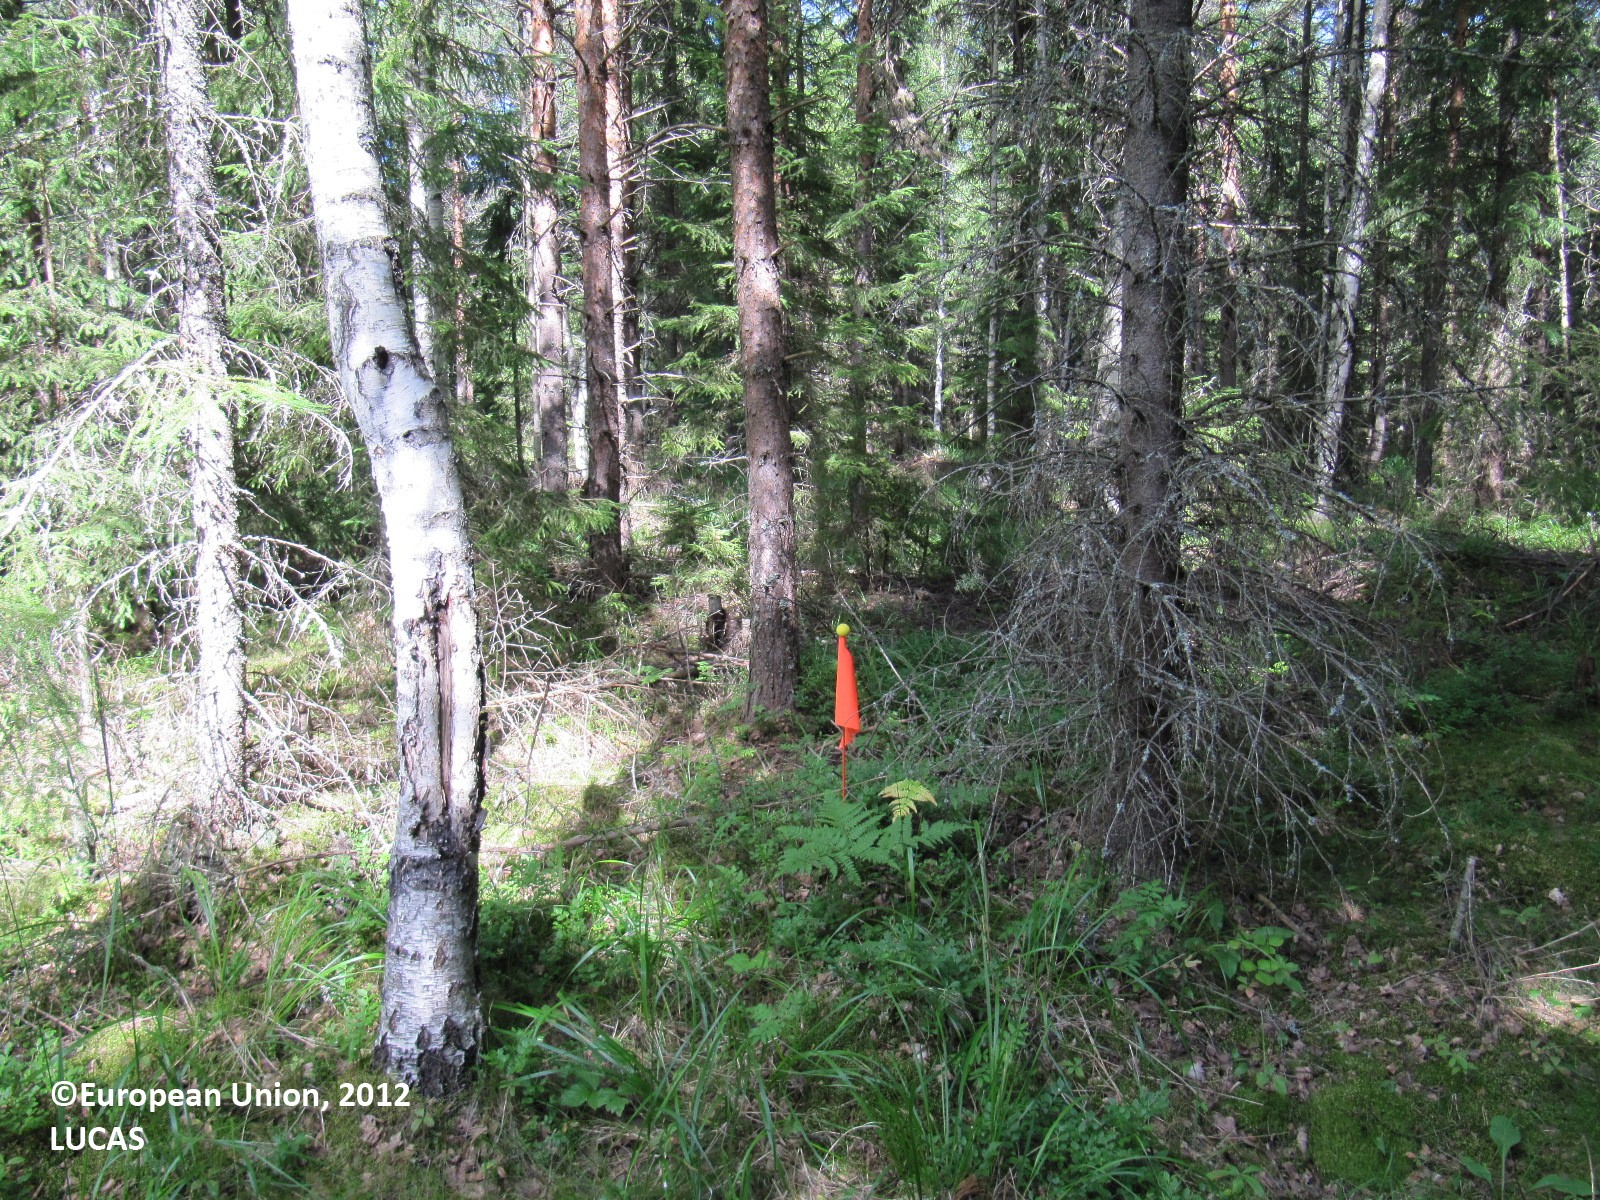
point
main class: Woodland
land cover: Spruce dominated mixed woodland
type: boreal forest
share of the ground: > 75 %
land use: Forestry
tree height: > 5 m
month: July
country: FI
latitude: 61.0152
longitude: 24.2117
